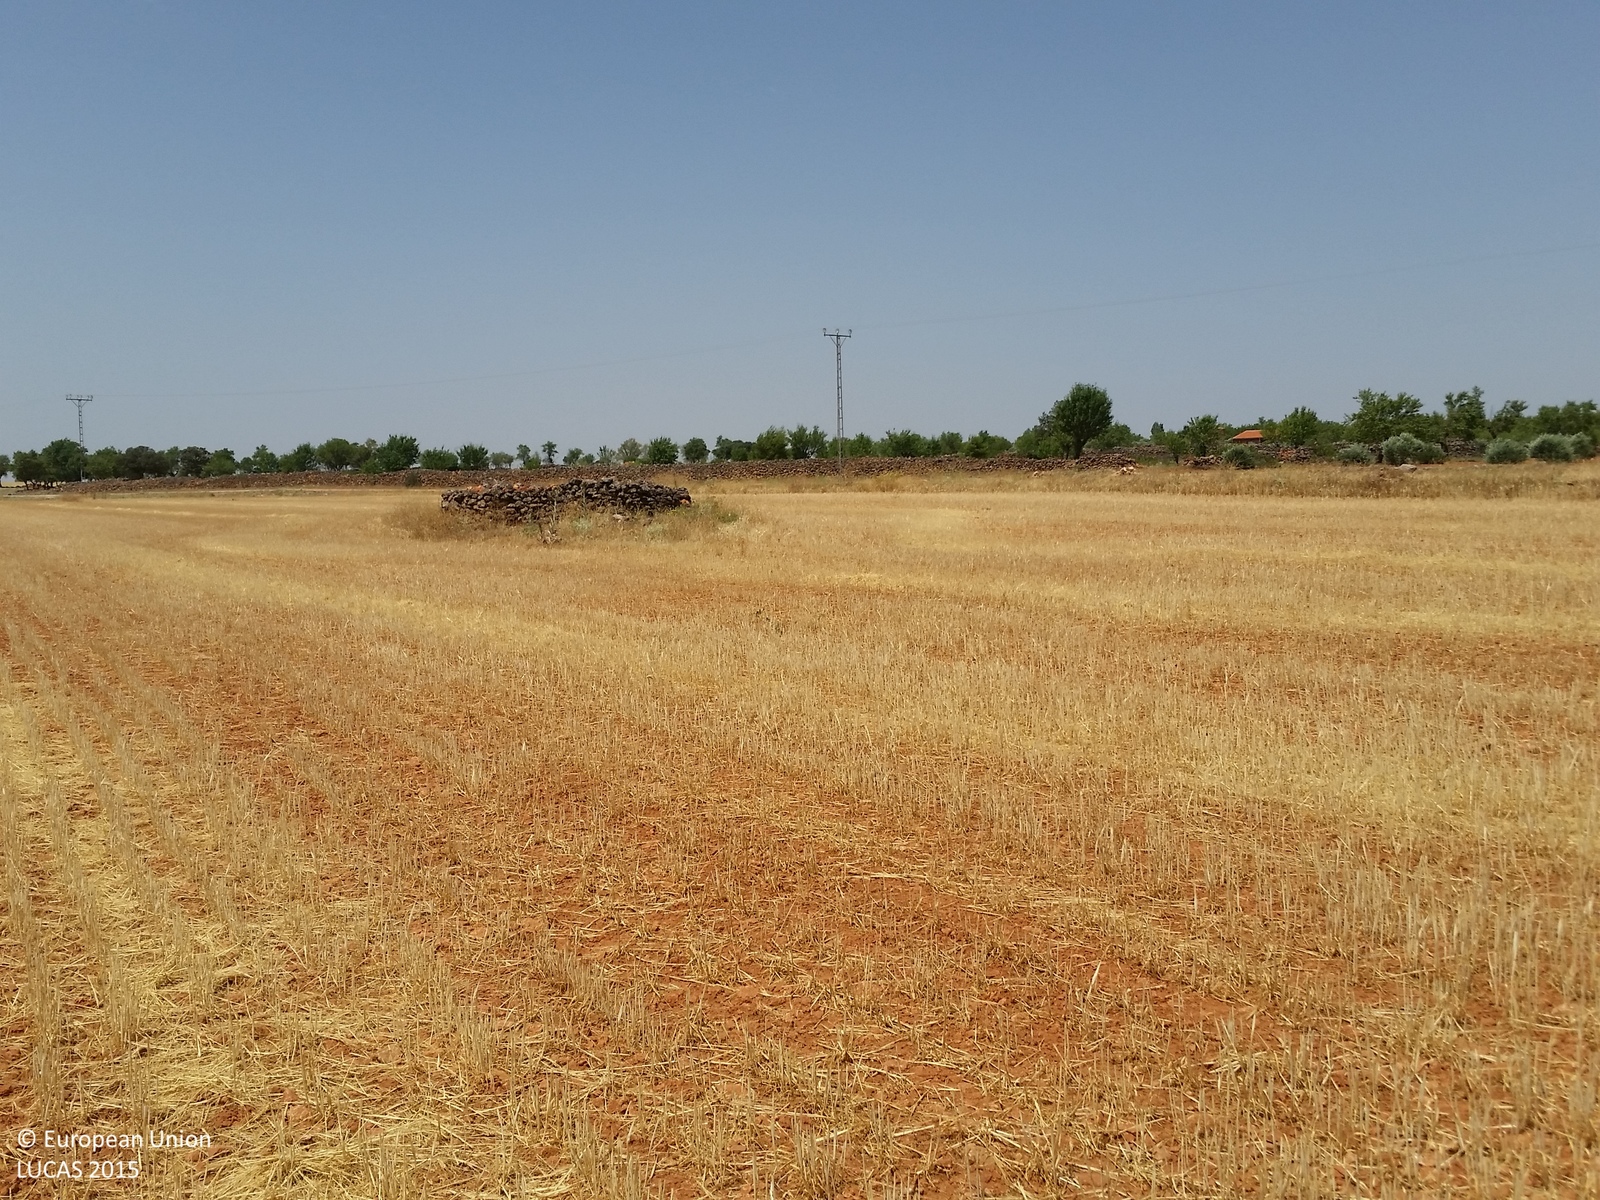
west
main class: Cropland
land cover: Barley
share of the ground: < 10 %
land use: Agriculture (excluding fallow land and kitchen gardens)
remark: Harvested field
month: June
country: ES
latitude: 38.7795
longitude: -2.5618
